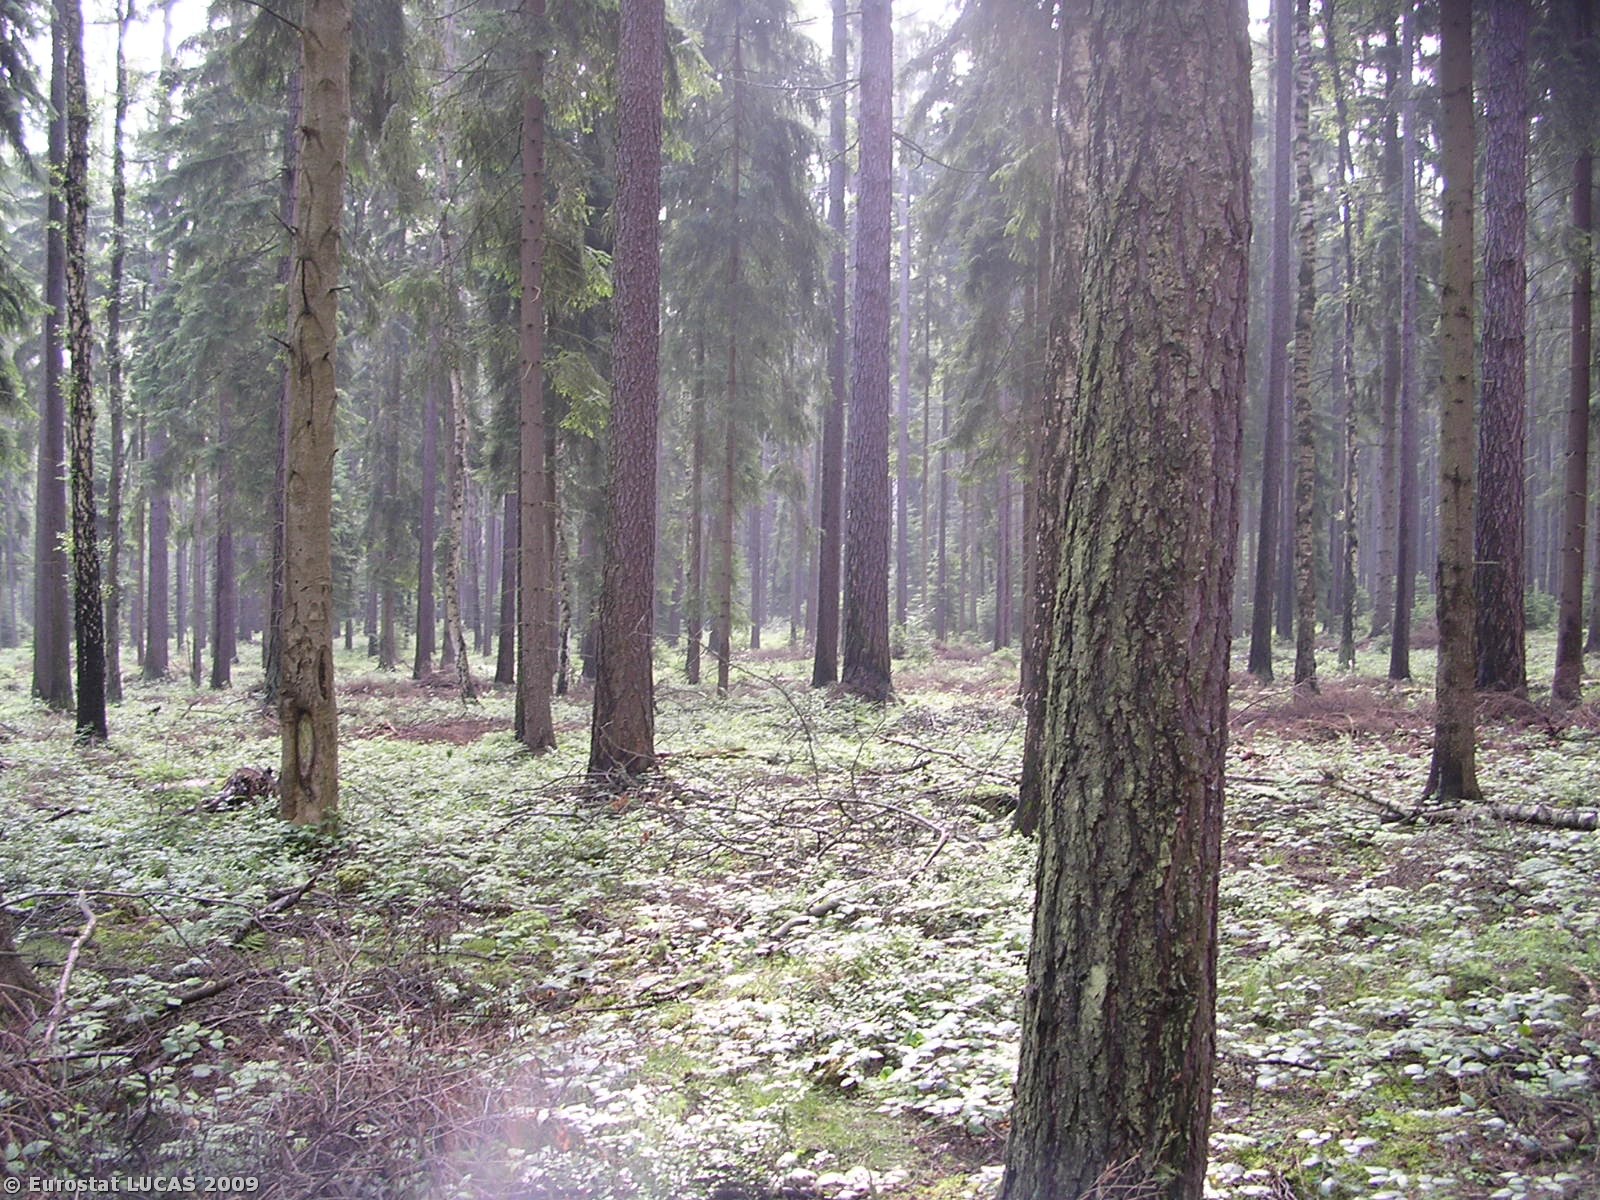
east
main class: Woodland
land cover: Coniferous woodland
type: hemiboreal forest and nemoral coniferous forest and mixed broadleaved-coniferous forest
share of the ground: > 75 %
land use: Forestry
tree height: > 5 m
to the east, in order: Coniferous woodland; Tracks; Coniferous woodland
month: June
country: CZ
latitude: 50.5844
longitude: 14.8752
